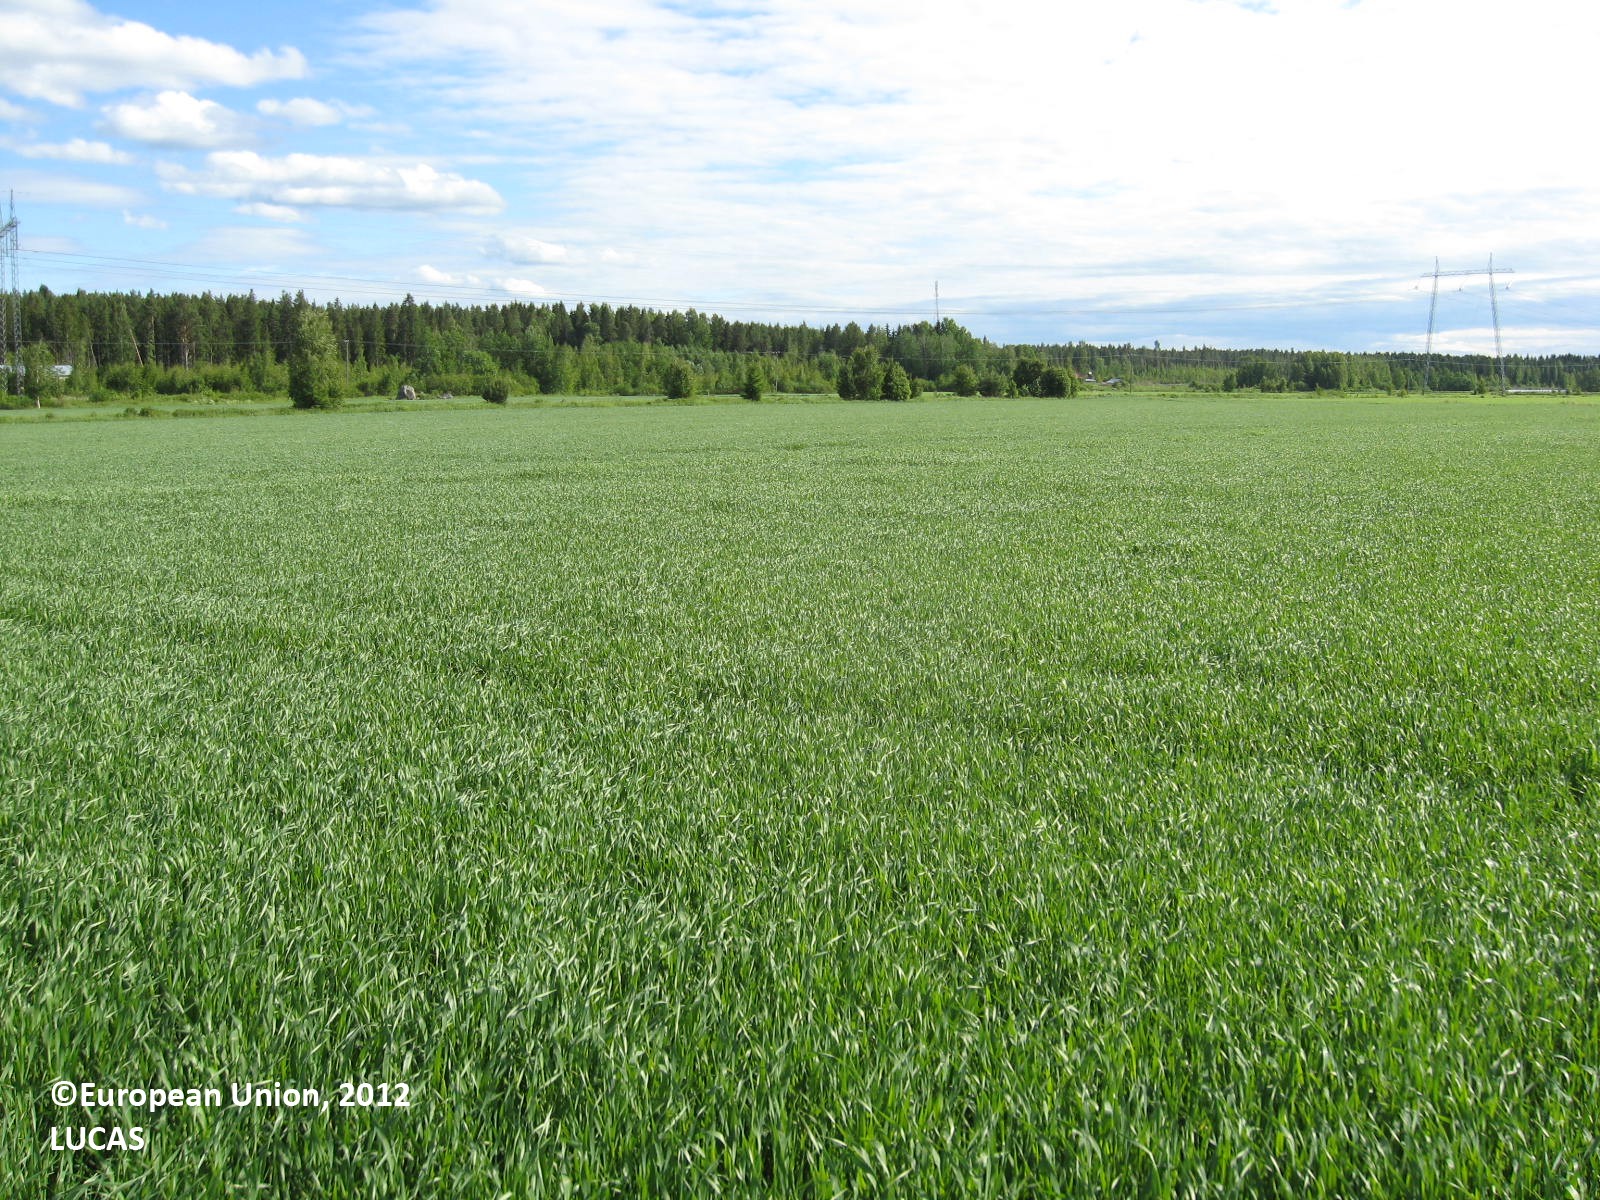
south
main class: Cropland
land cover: Barley
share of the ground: > 75 %
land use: Agriculture (excluding fallow land and kitchen gardens)
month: June
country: FI
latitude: 62.7862
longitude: 22.6985
